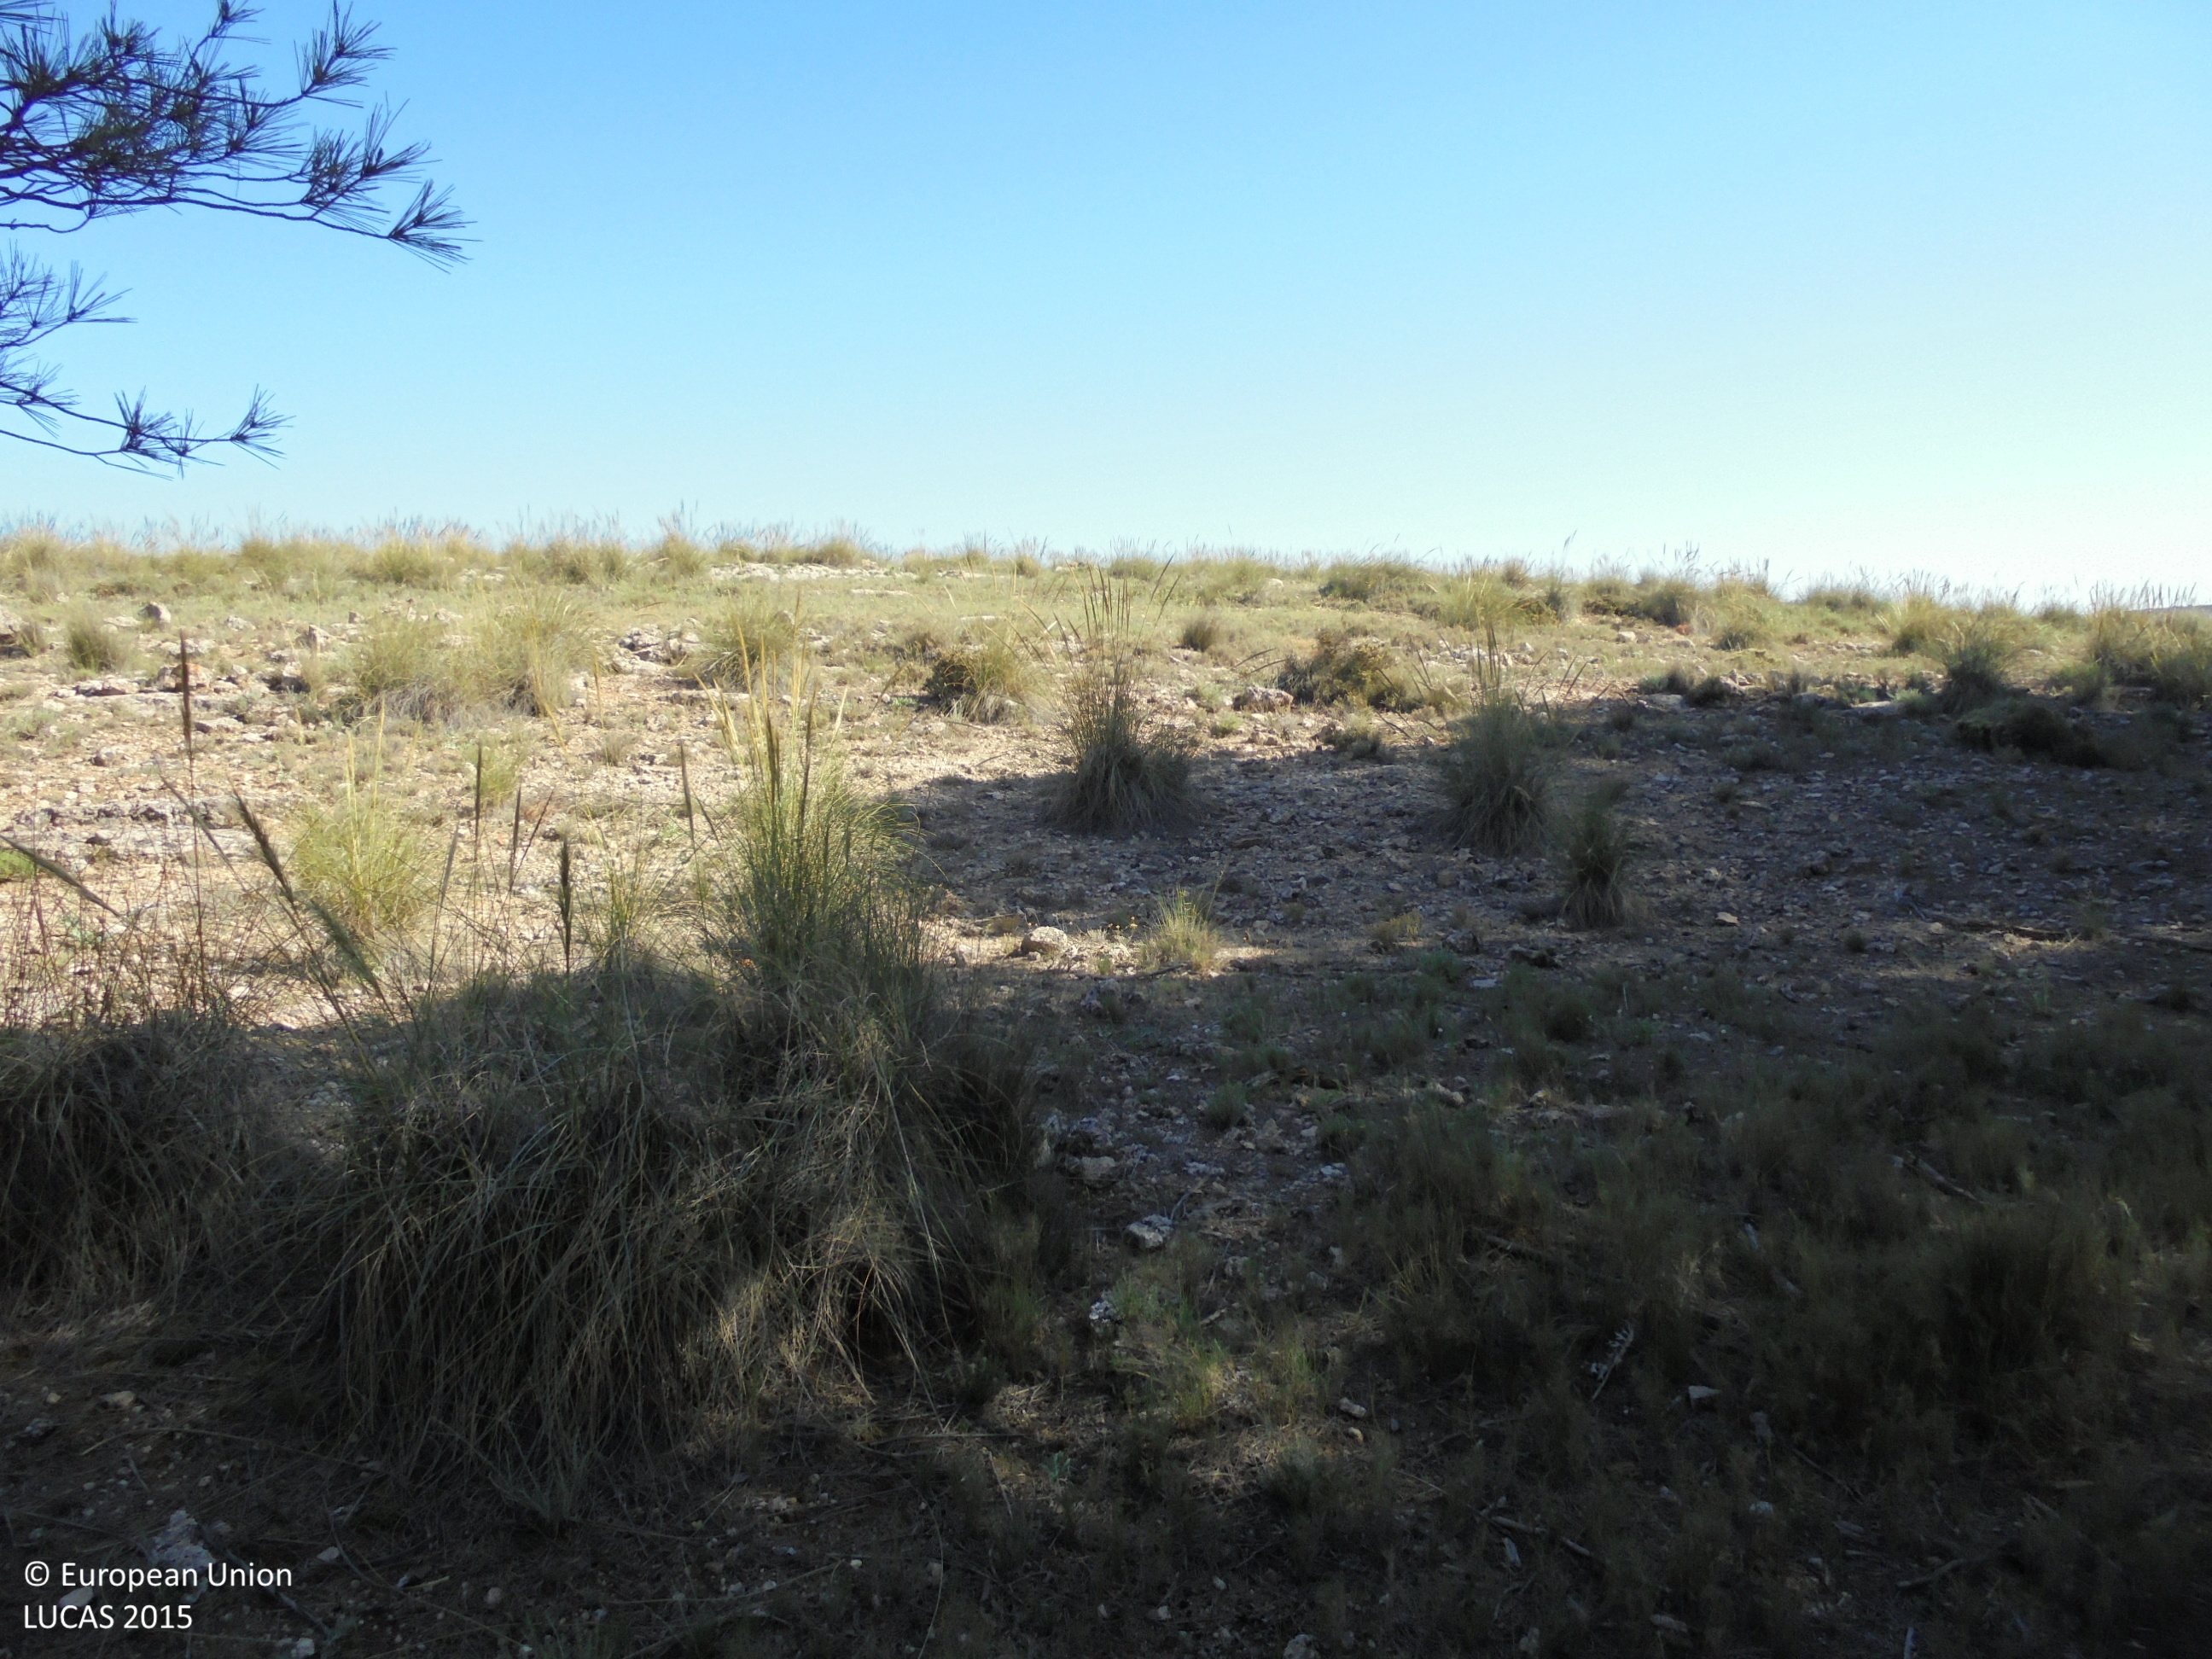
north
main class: Woodland
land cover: Pine dominated coniferous woodland
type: coniferous forest of the mediterranean region
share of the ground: > 75 %
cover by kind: coniferous forest trees 80 %, herbaceous plants 10 %, unconsolidated bare surface 10 %
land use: Semi-natural and natural areas not in use
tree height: > 5 m
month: May
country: ES
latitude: 38.9245
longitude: -1.7060
